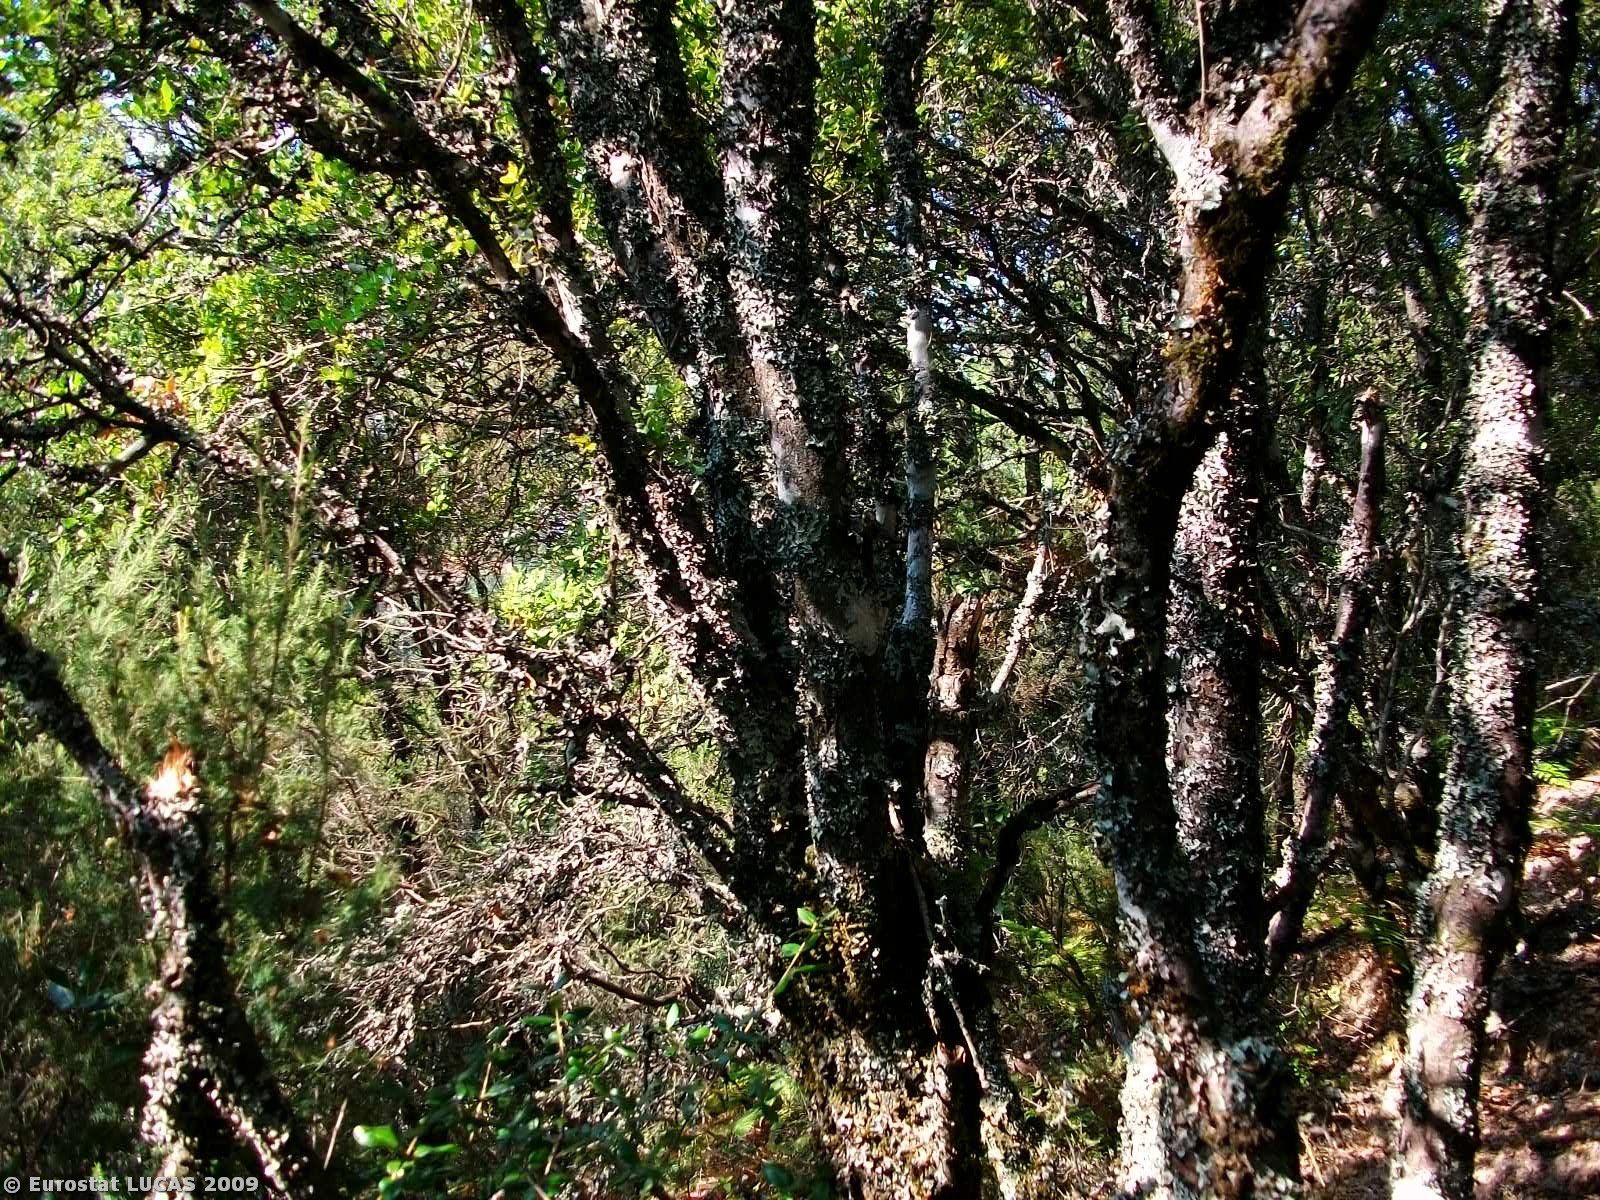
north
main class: Woodland
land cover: Mixed woodland
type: mesophytic deciduous forest
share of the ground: > 75 %
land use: Forestry
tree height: > 5 m
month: August
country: GR
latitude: 39.6501
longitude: 20.4766
